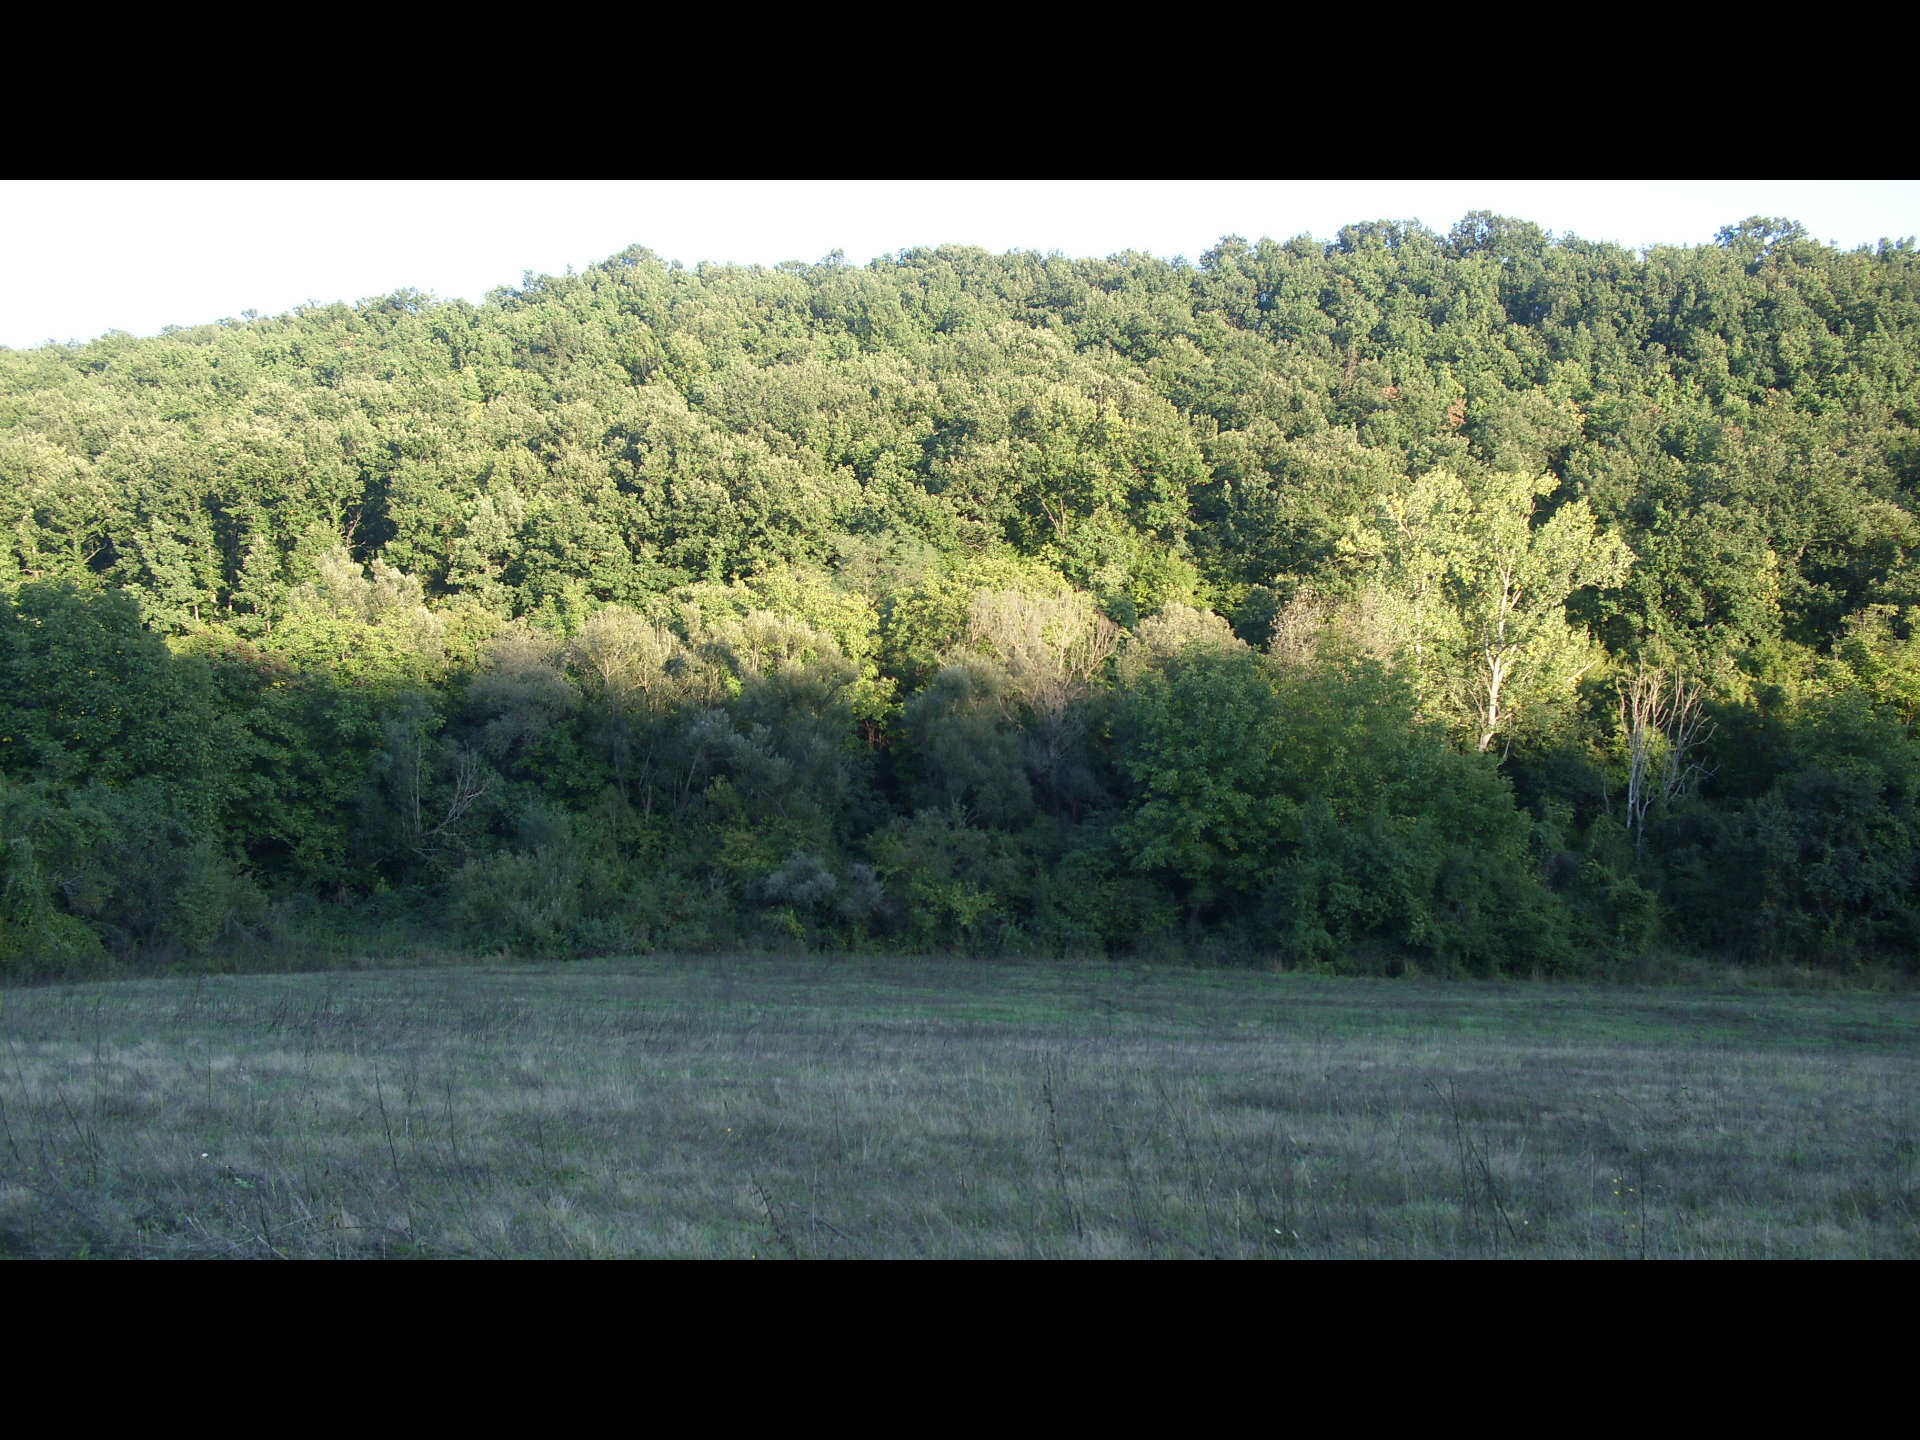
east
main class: Grassland
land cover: Grassland without tree/shrub cover
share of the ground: > 75 %
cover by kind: herbaceous plants 100 %
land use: Agriculture (excluding fallow land and kitchen gardens)
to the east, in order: Grassland without tree/shrub cover; Tracks; Grassland without tree/shrub cover; Shrubland with sparse tree cover; Broadleaved woodland; Inland fresh running water; Broadleaved woodland; Grassland with sparse tree/shrub cover; Broadleaved woodland
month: October
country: BG
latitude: 43.4349
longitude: 23.0212
